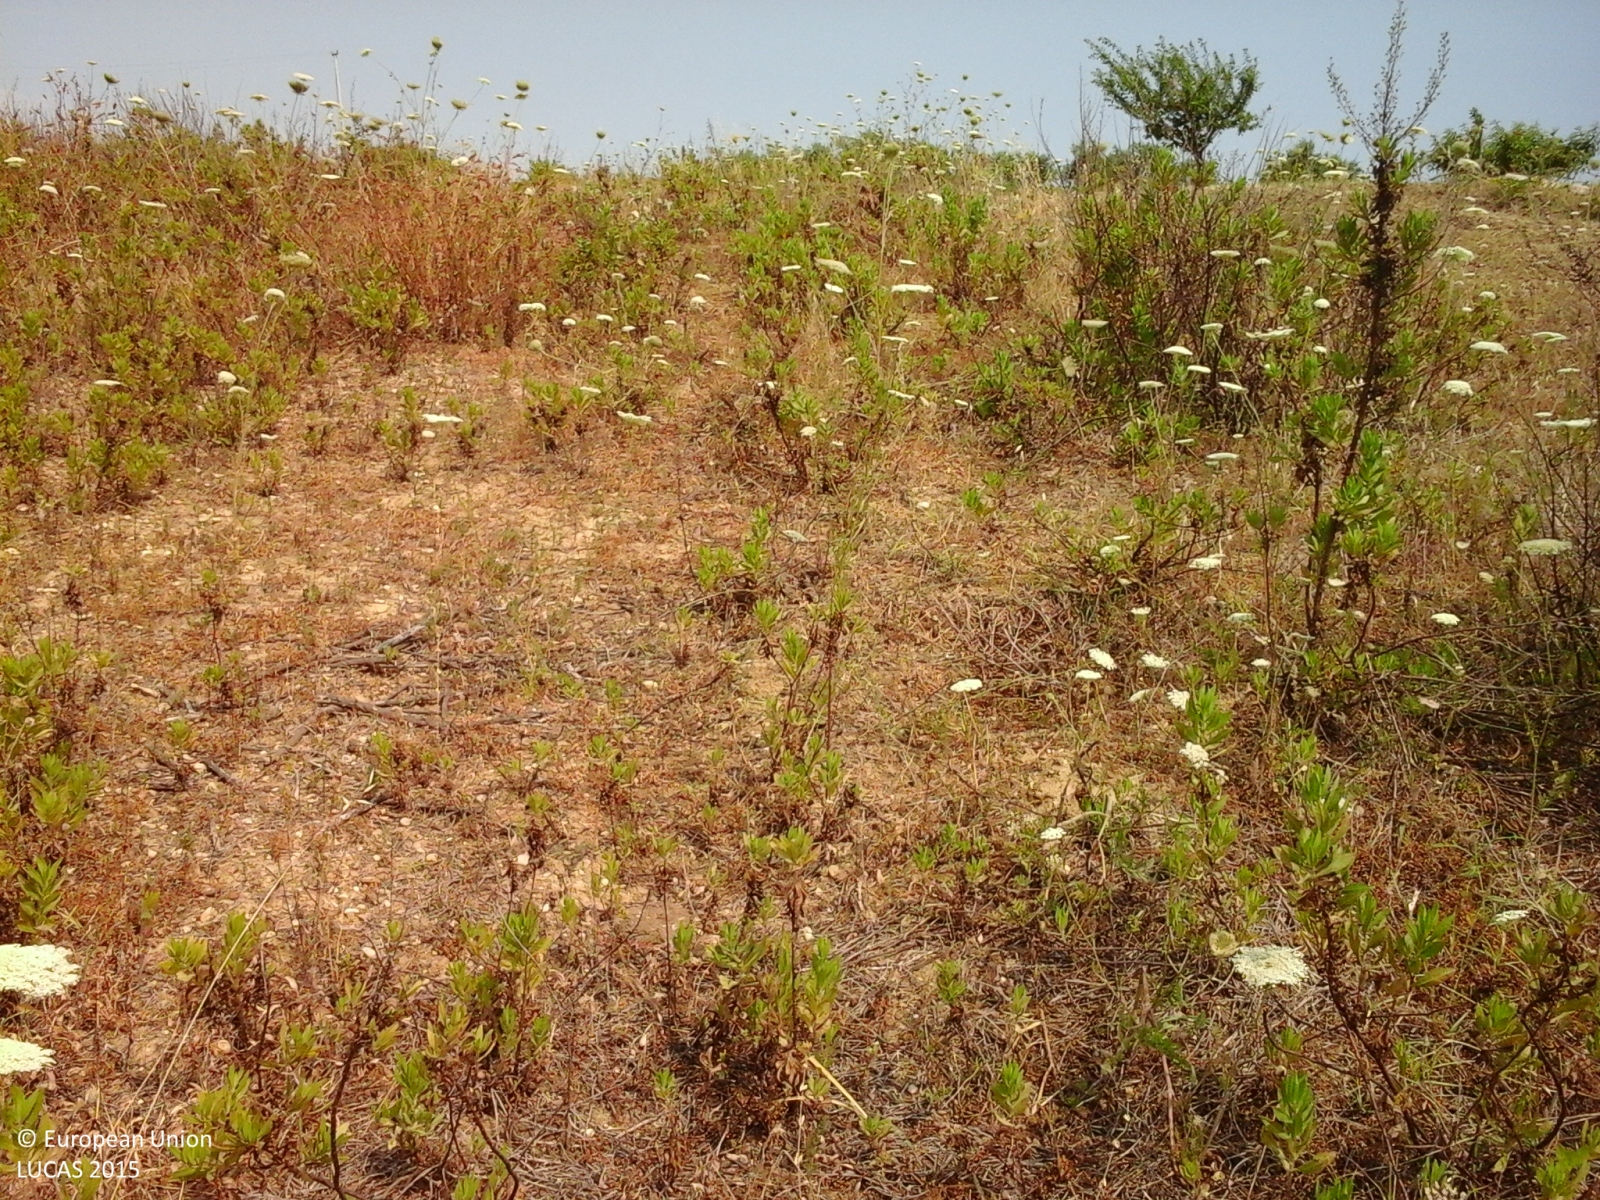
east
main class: Grassland
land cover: Spontaneously vegetated surfaces
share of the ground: > 75 %
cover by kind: herbaceous plants 100 %
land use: Agriculture (excluding fallow land and kitchen gardens)
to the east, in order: Spontaneously vegetated surfaces; Grass margins; Artificial constructions; Paved roads, cycling and walking lanes; Artificial constructions; Grass margins; Olive groves; Fences; Grass margins; Paved roads, cycling and walking lanes; Grass margins; Vineyards
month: June
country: IT
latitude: 37.3986
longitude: 13.3292
